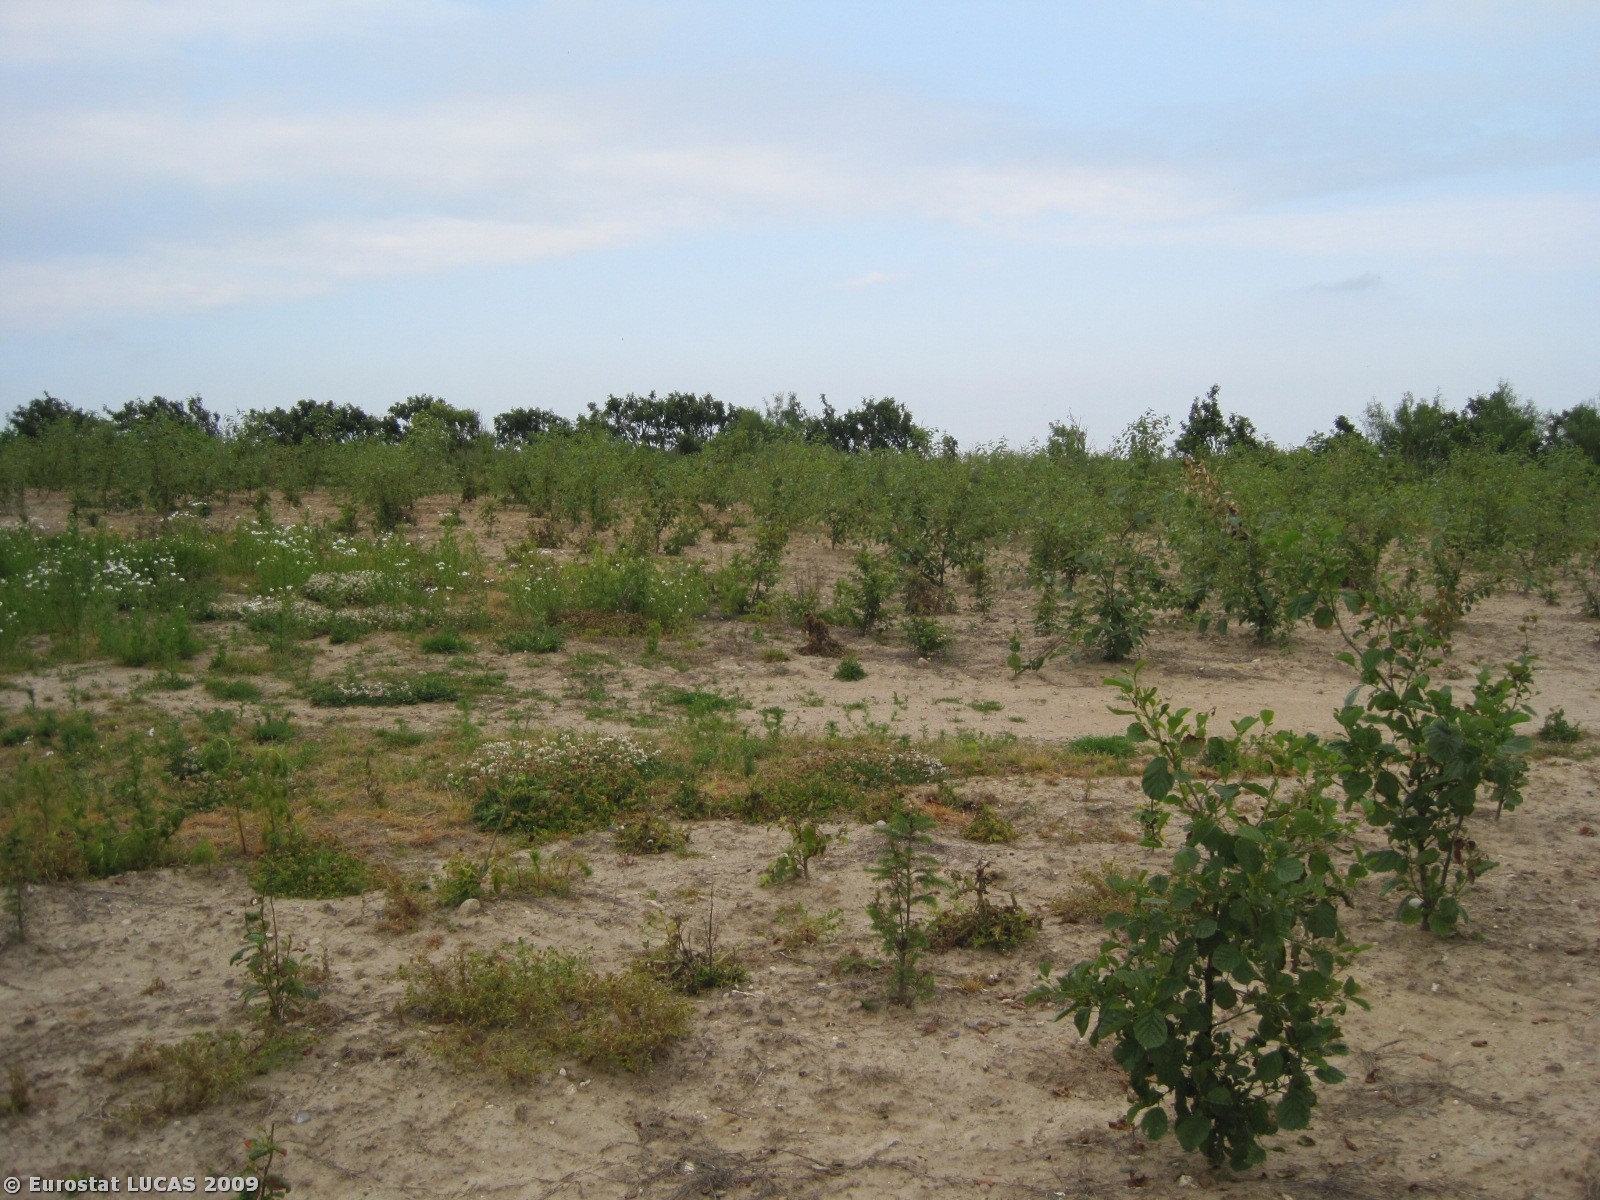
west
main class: Grassland
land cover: Grassland with sparse tree/shrub cover
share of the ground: 10 - 25 %
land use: Agriculture (excluding fallow land and kitchen gardens)
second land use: Amenities, museums, leisure
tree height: < 5 m
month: June
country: DK
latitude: 56.5724
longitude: 8.3256
